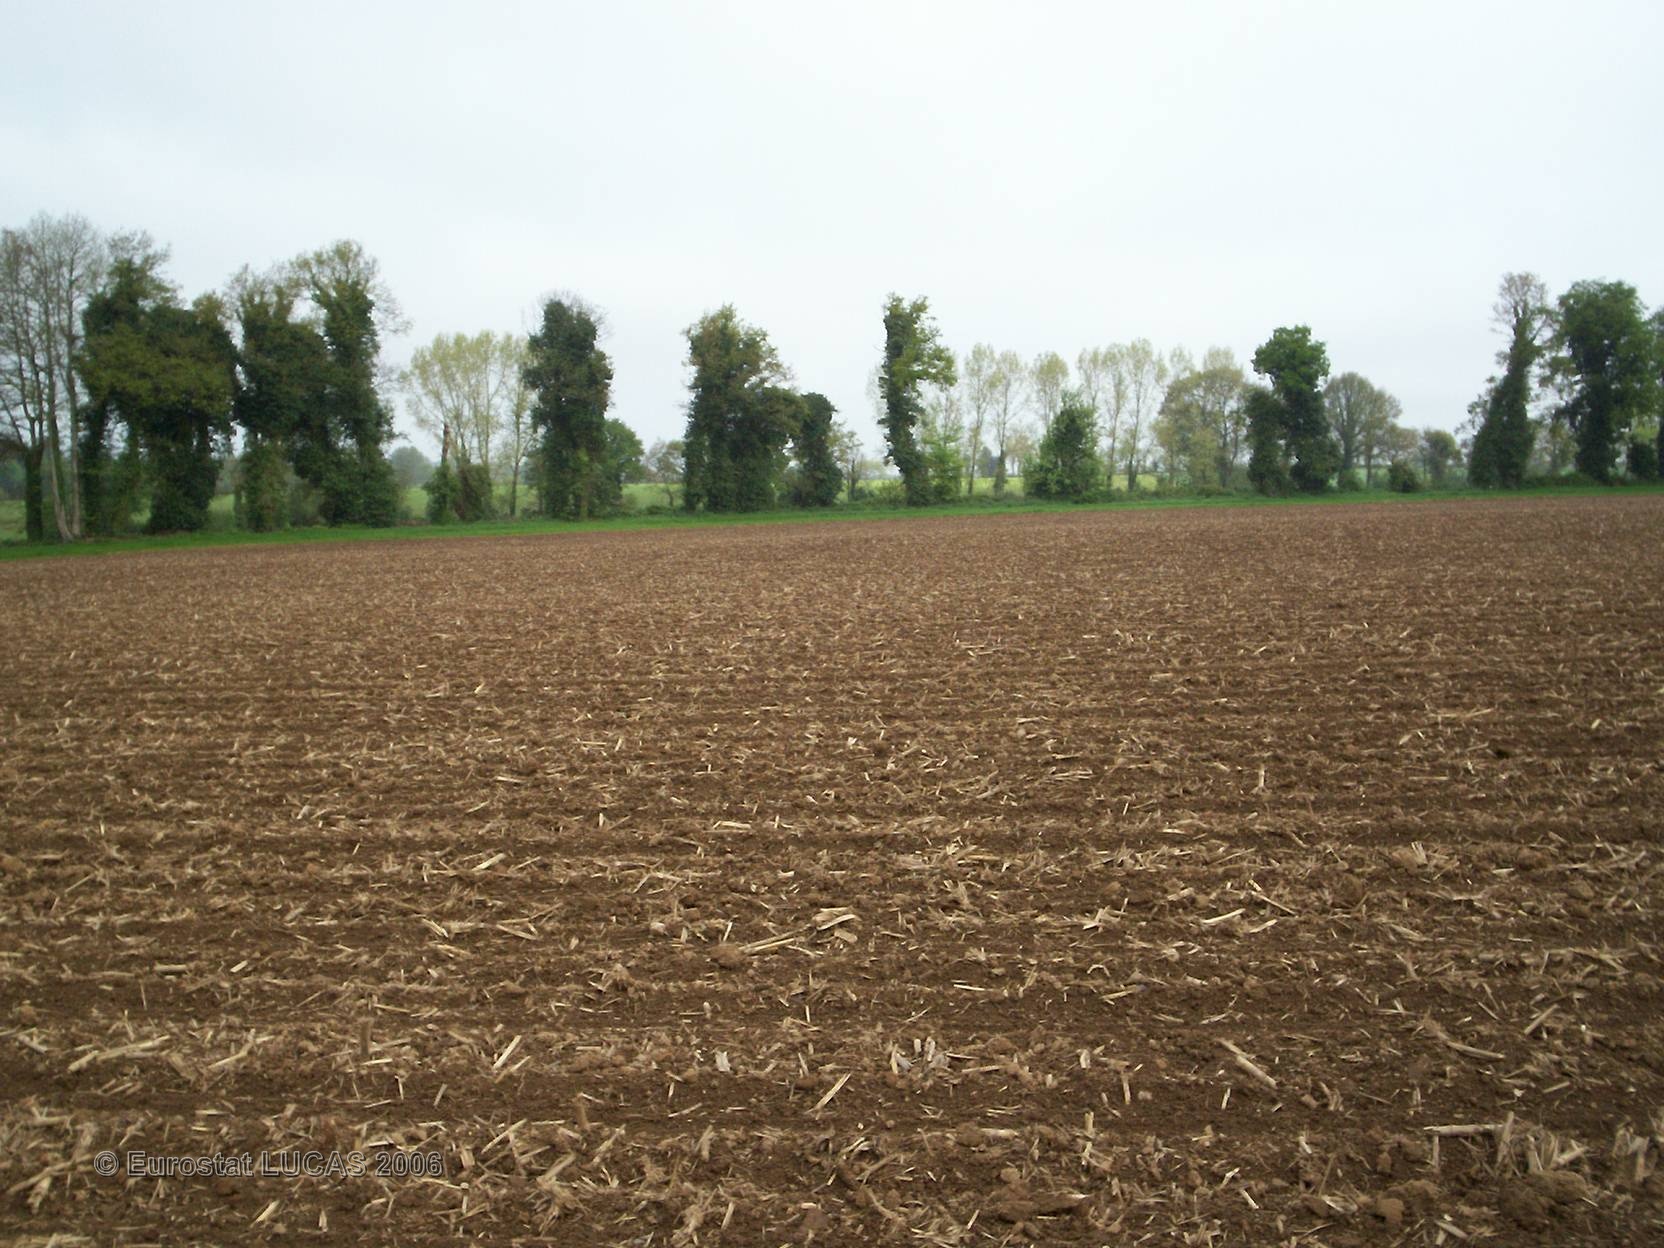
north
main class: Cropland
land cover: Maize
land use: Agriculture (excluding fallow land and kitchen gardens)
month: May
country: FR
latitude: 48.1297
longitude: -2.9529
